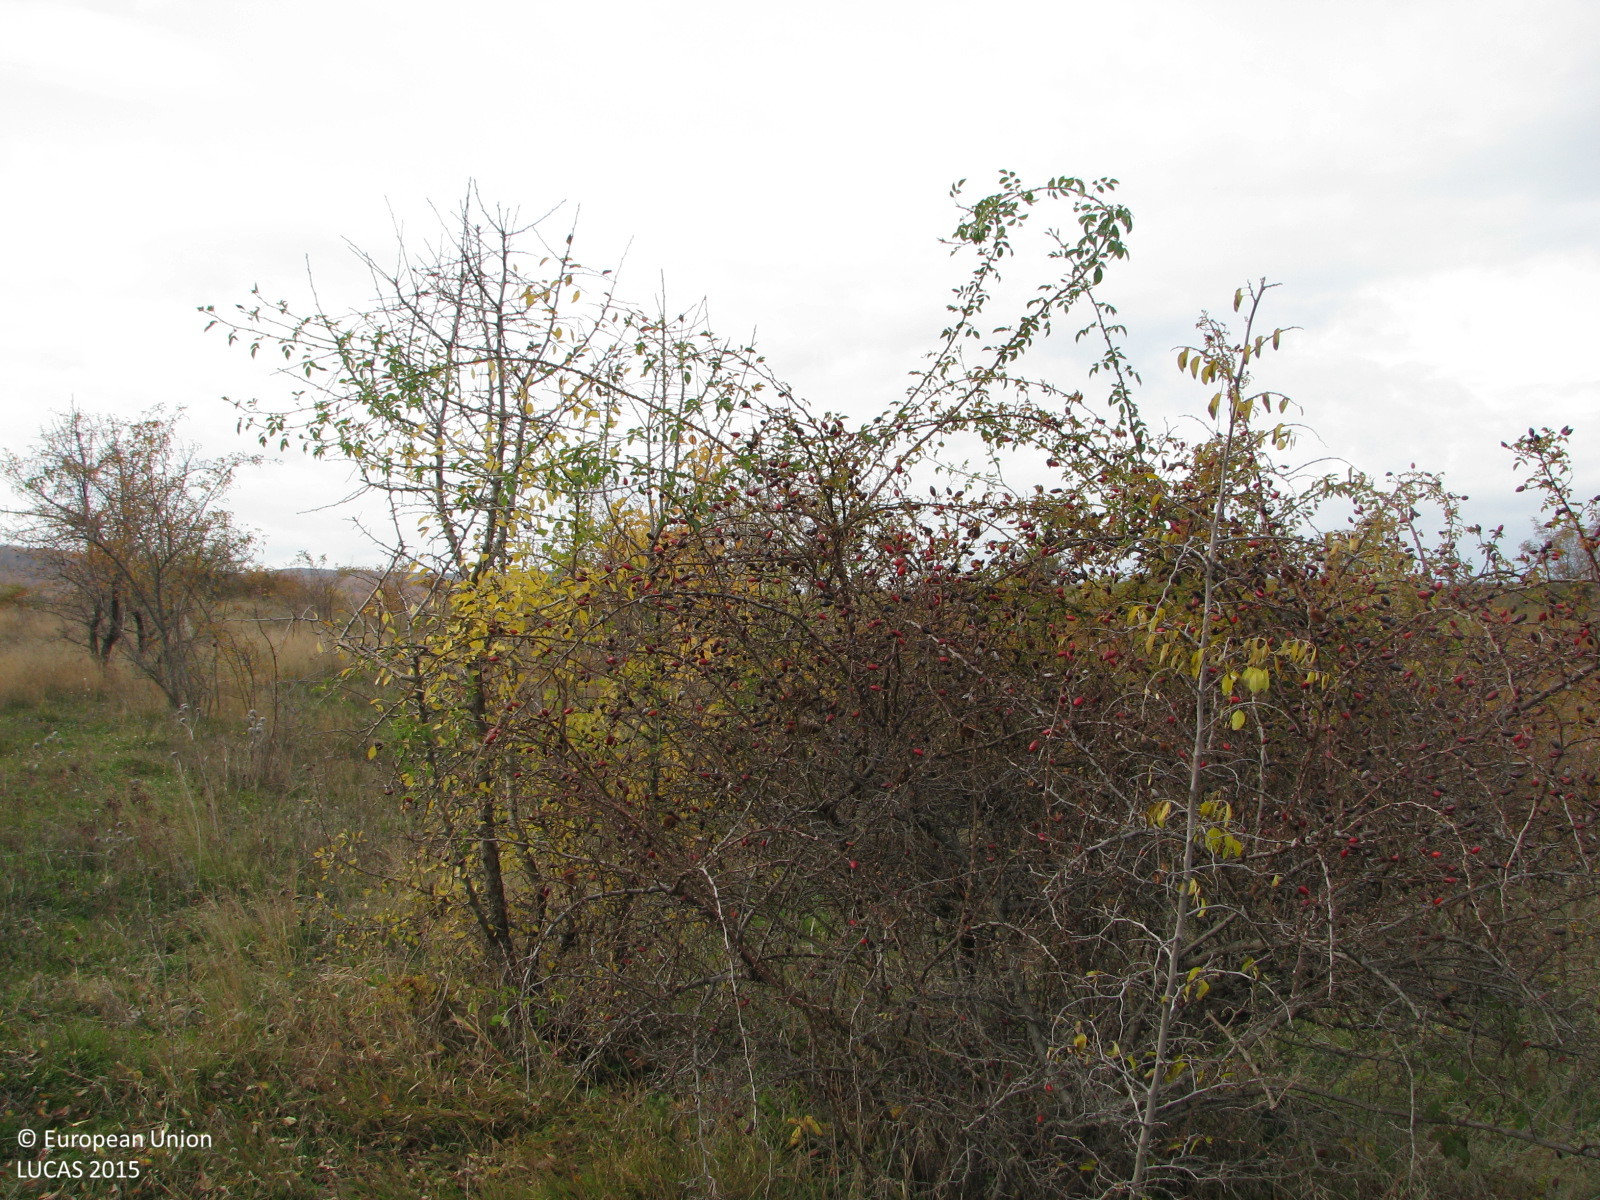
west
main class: Grassland
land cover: Grassland with sparse tree/shrub cover
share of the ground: > 75 %
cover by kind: herbaceous plants 85 %, shrubs 10 %, broadleaved forest trees 5 %
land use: Agriculture (excluding fallow land and kitchen gardens)
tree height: < 5 m
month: November
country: BG
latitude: 41.9710
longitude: 26.3856
